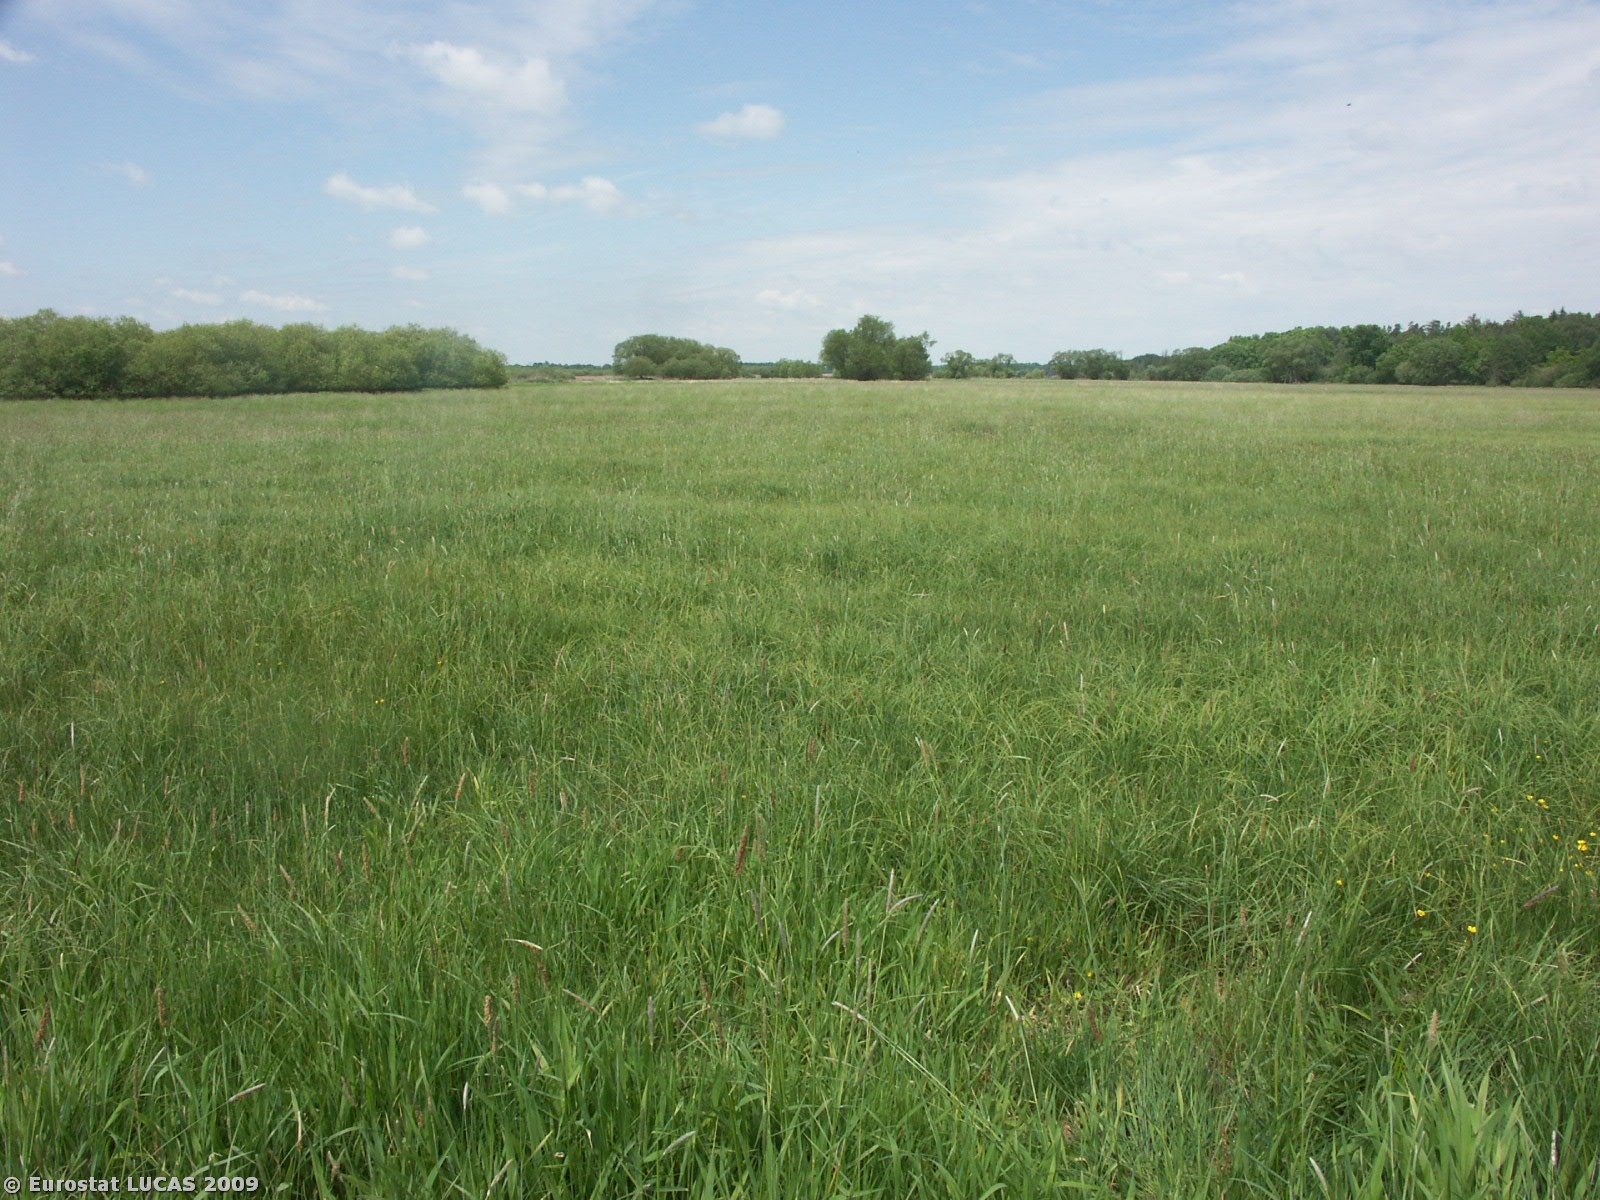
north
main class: Grassland
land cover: Grassland without tree/shrub cover
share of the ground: > 75 %
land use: Agriculture (excluding fallow land and kitchen gardens)
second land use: Nature reserves
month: May
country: CZ
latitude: 49.0213
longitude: 14.7741
